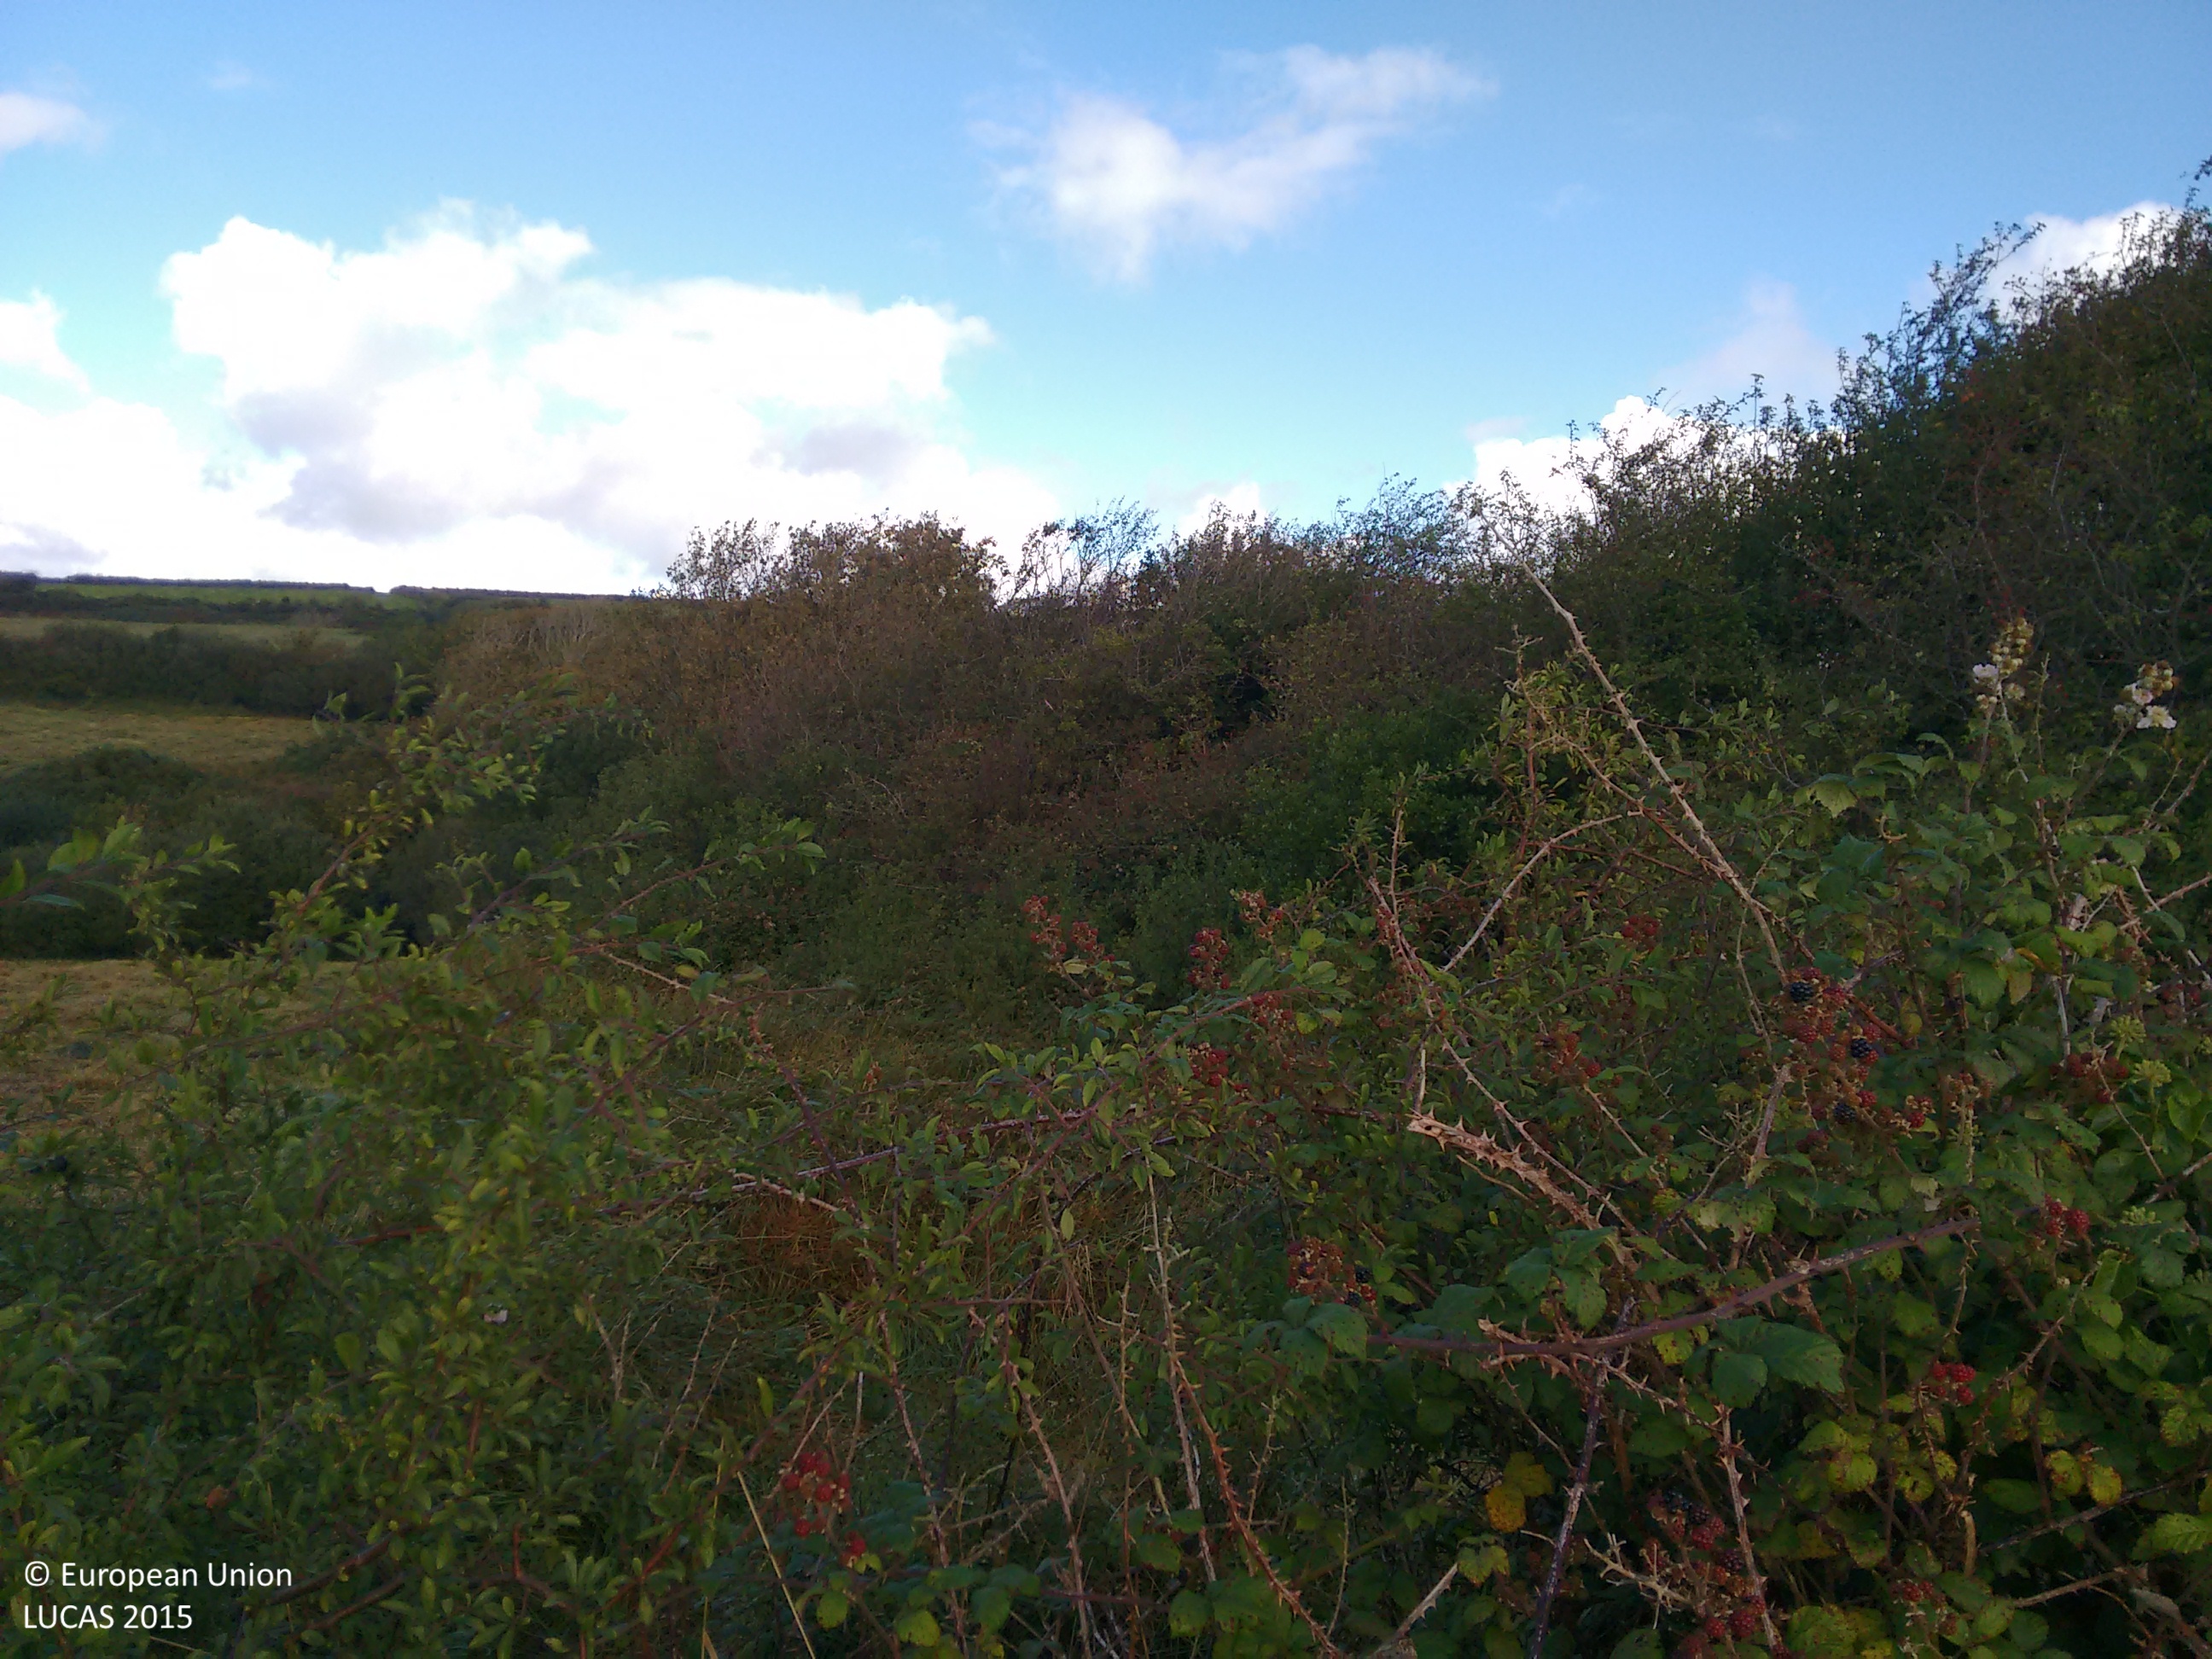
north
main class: Grassland
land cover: Grassland without tree/shrub cover
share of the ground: > 75 %
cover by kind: herbaceous plants 100 %
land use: Agriculture (excluding fallow land and kitchen gardens)
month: September
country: IE
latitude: 52.6253
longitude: -9.1734
